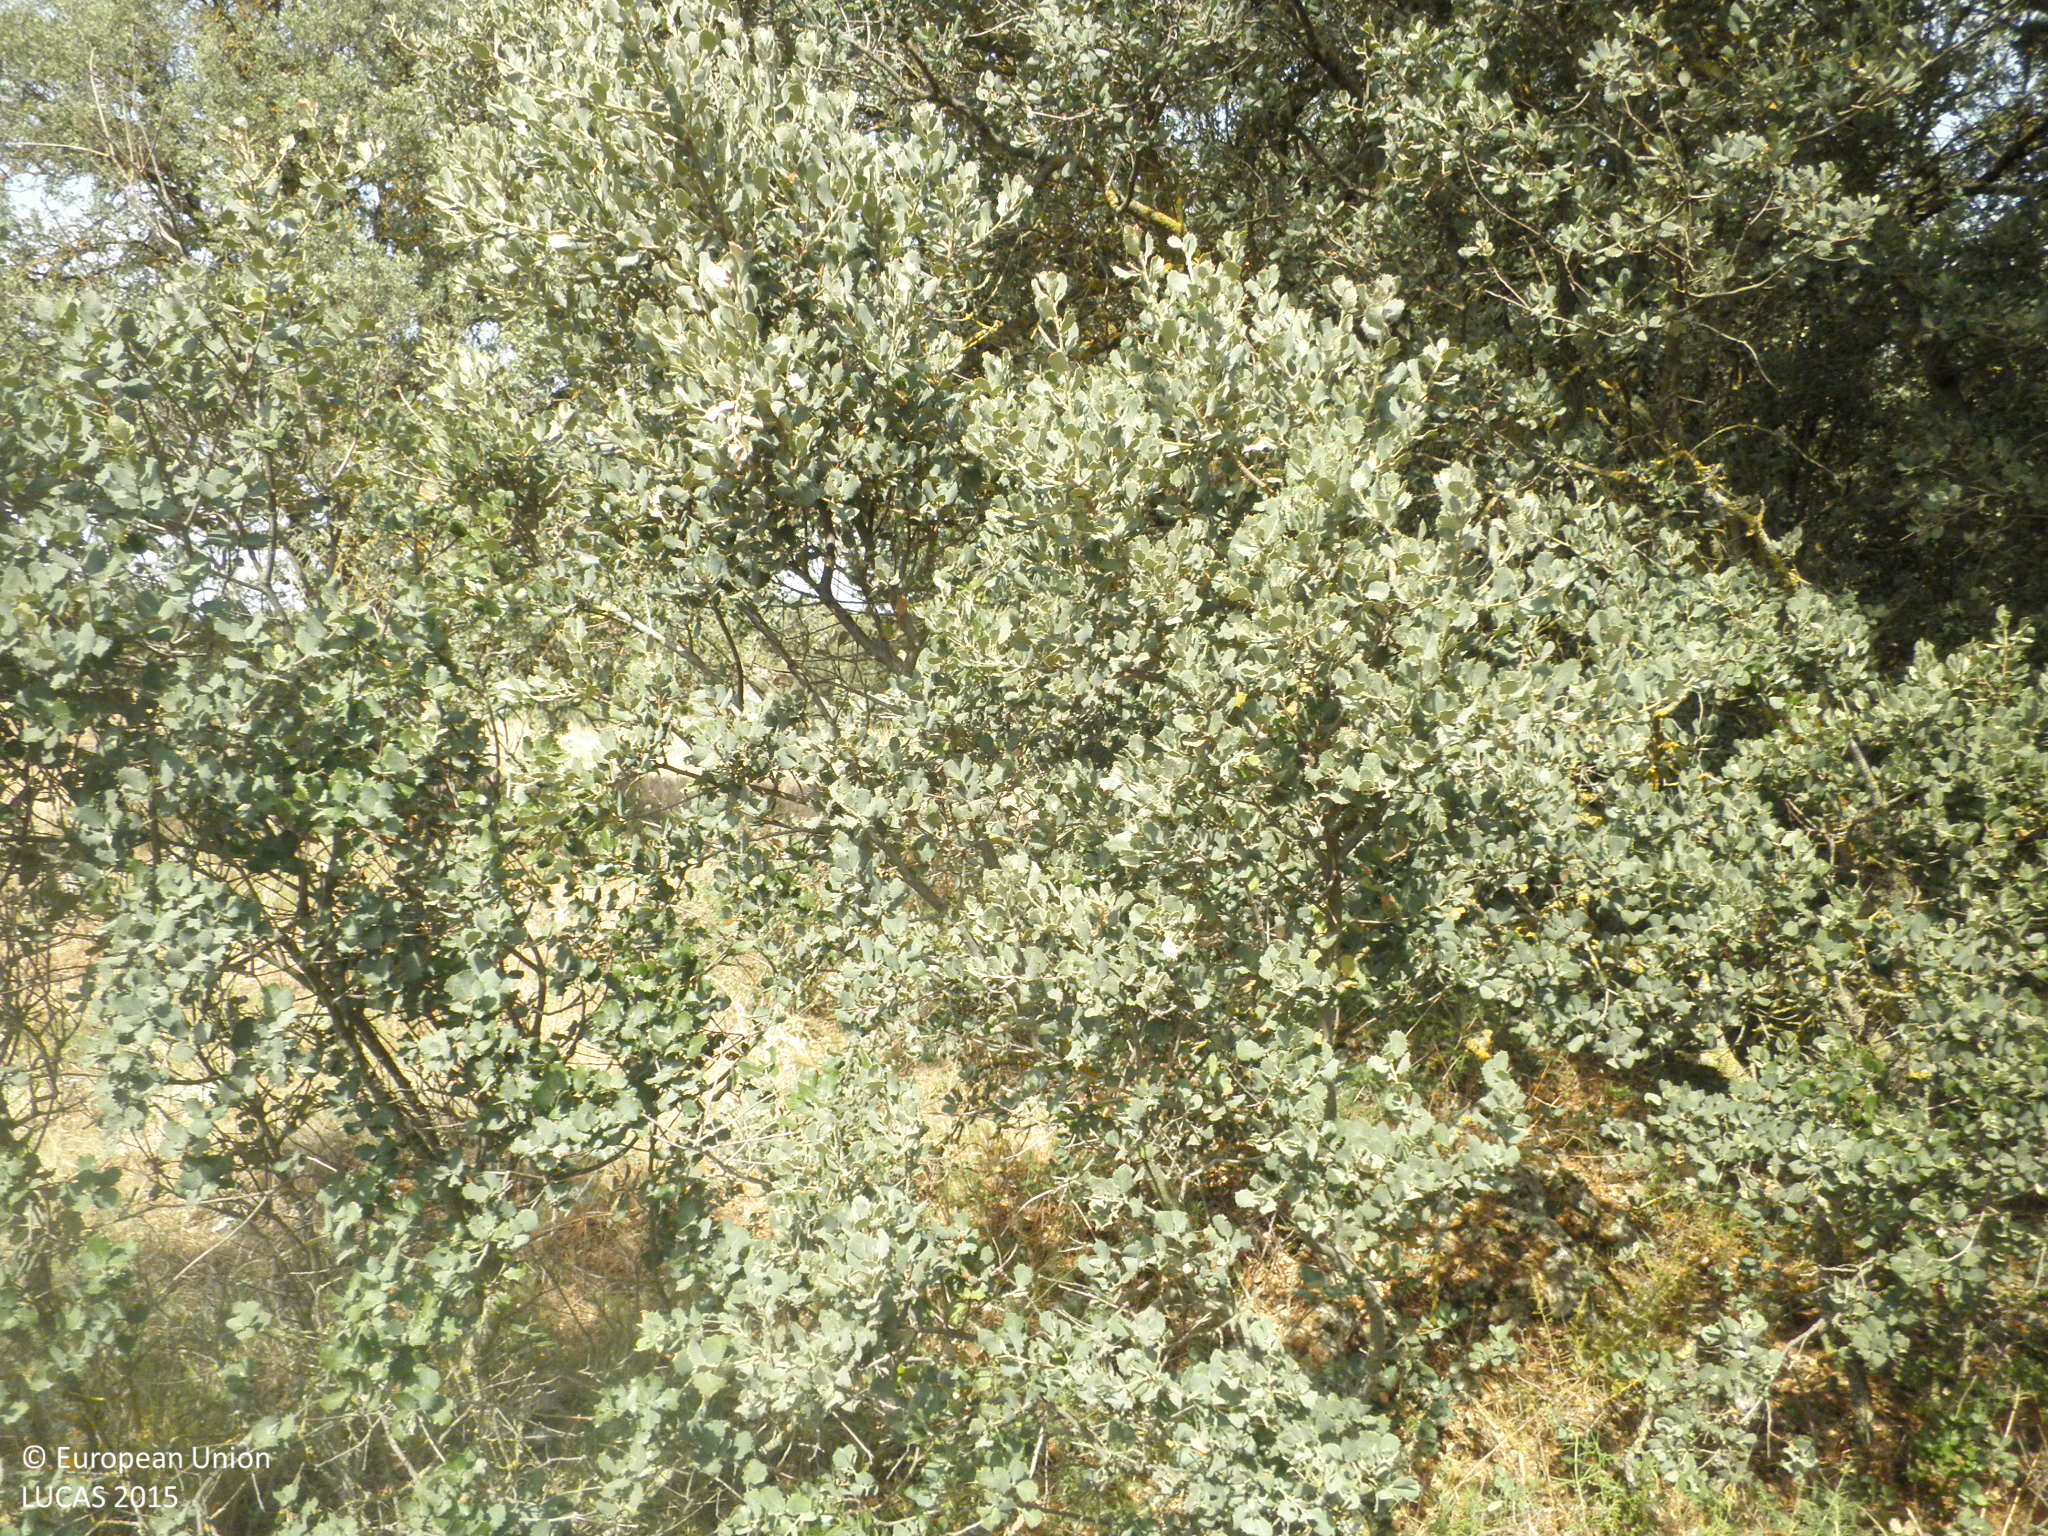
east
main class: Woodland
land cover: Broadleaved woodland
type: broadleaved evergreen forest
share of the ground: 25 - 50 %
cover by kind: herbaceous plants 55 %, broadleaved forest trees 30 %, consolidated bare surface 10 %, shrubs 5 %
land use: Semi-natural and natural areas not in use
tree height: > 5 m
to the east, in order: Broadleaved woodland; Dry stone walls; Grass margins; Tracks; Broadleaved woodland; Grassland without tree/shrub cover; Rivers and streams; Broadleaved woodland; Grassland without tree/shrub cover; Barley; Broadleaved woodland
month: July
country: ES
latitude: 39.5261
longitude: -2.5889
